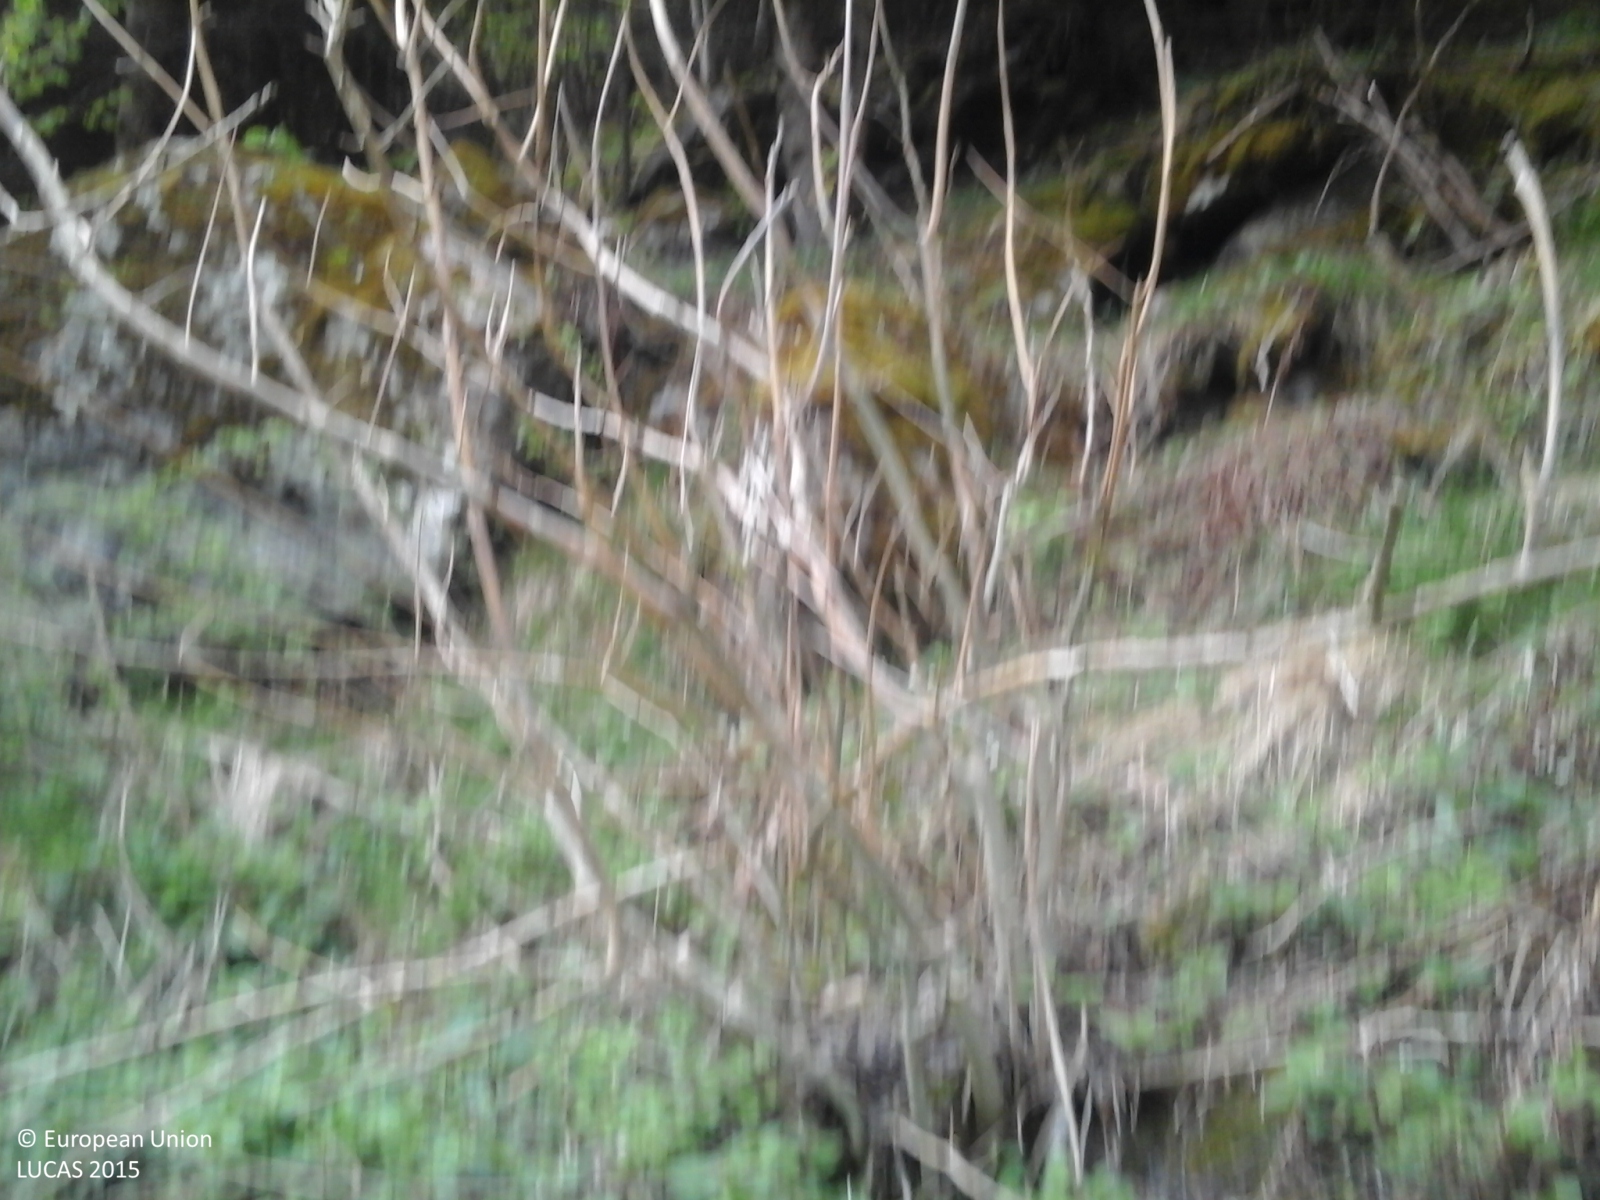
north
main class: Woodland
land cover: Spruce dominated coniferous woodland
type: alpine coniferous forest
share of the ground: > 75 %
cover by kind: coniferous forest trees 90 %, broadleaved forest trees 10 %
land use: Forestry
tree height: > 5 m
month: May
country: IT
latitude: 46.0249
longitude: 10.6579
